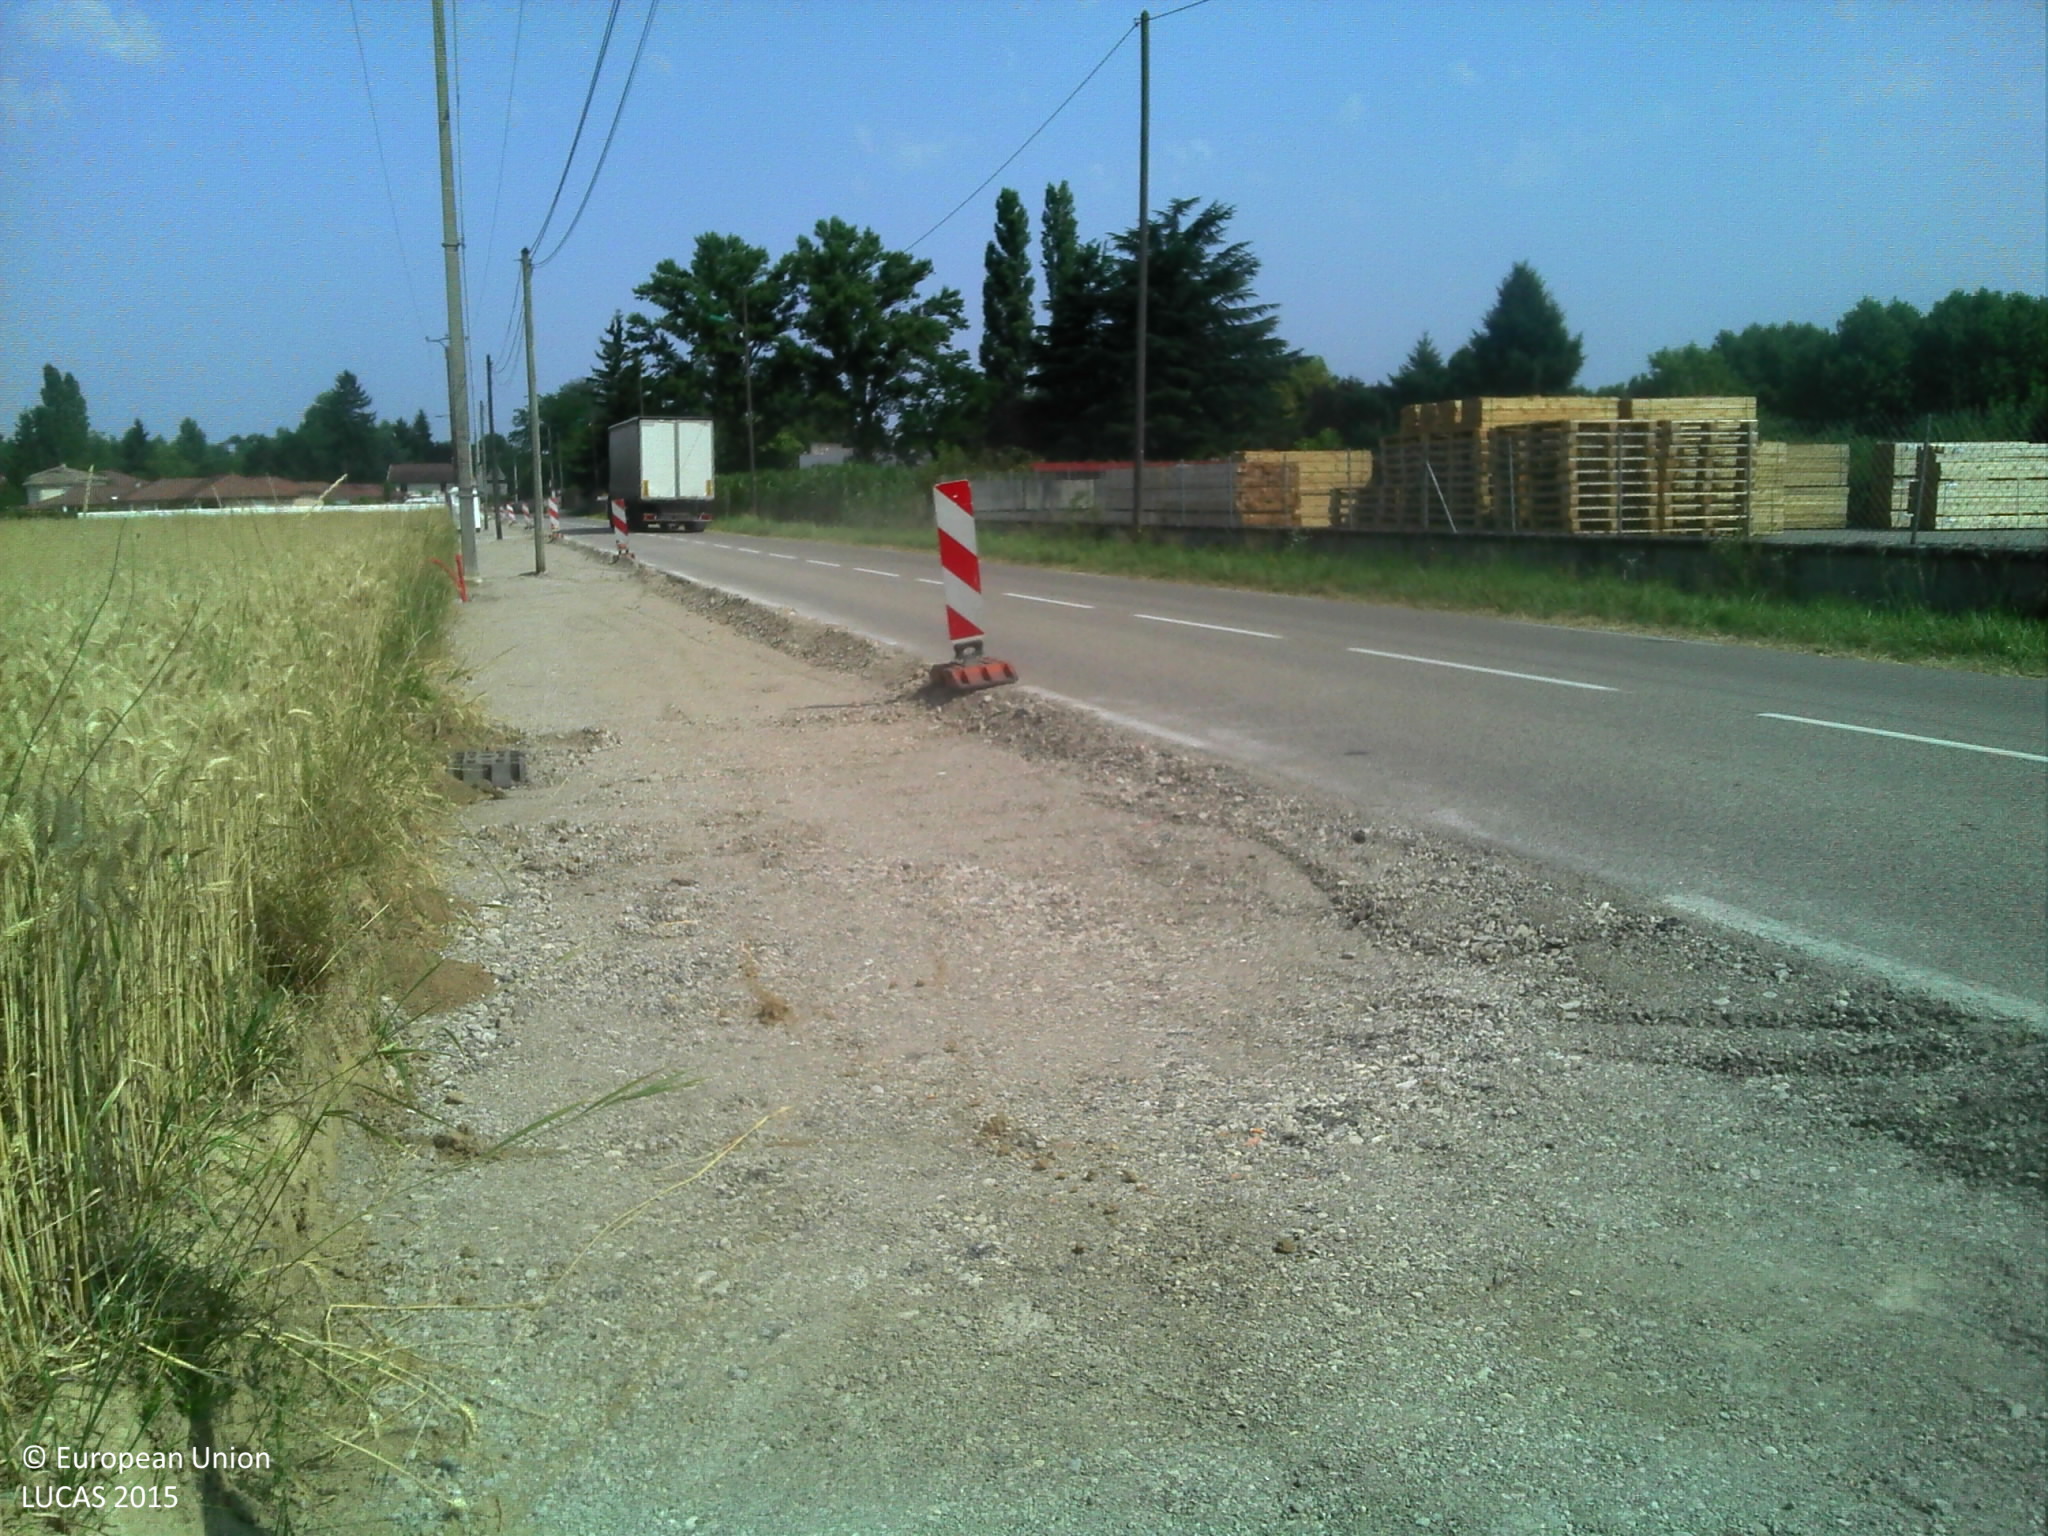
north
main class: Cropland
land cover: Durum wheat
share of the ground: > 75 %
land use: Agriculture (excluding fallow land and kitchen gardens)
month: July
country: FR
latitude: 45.7735
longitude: 5.1813
